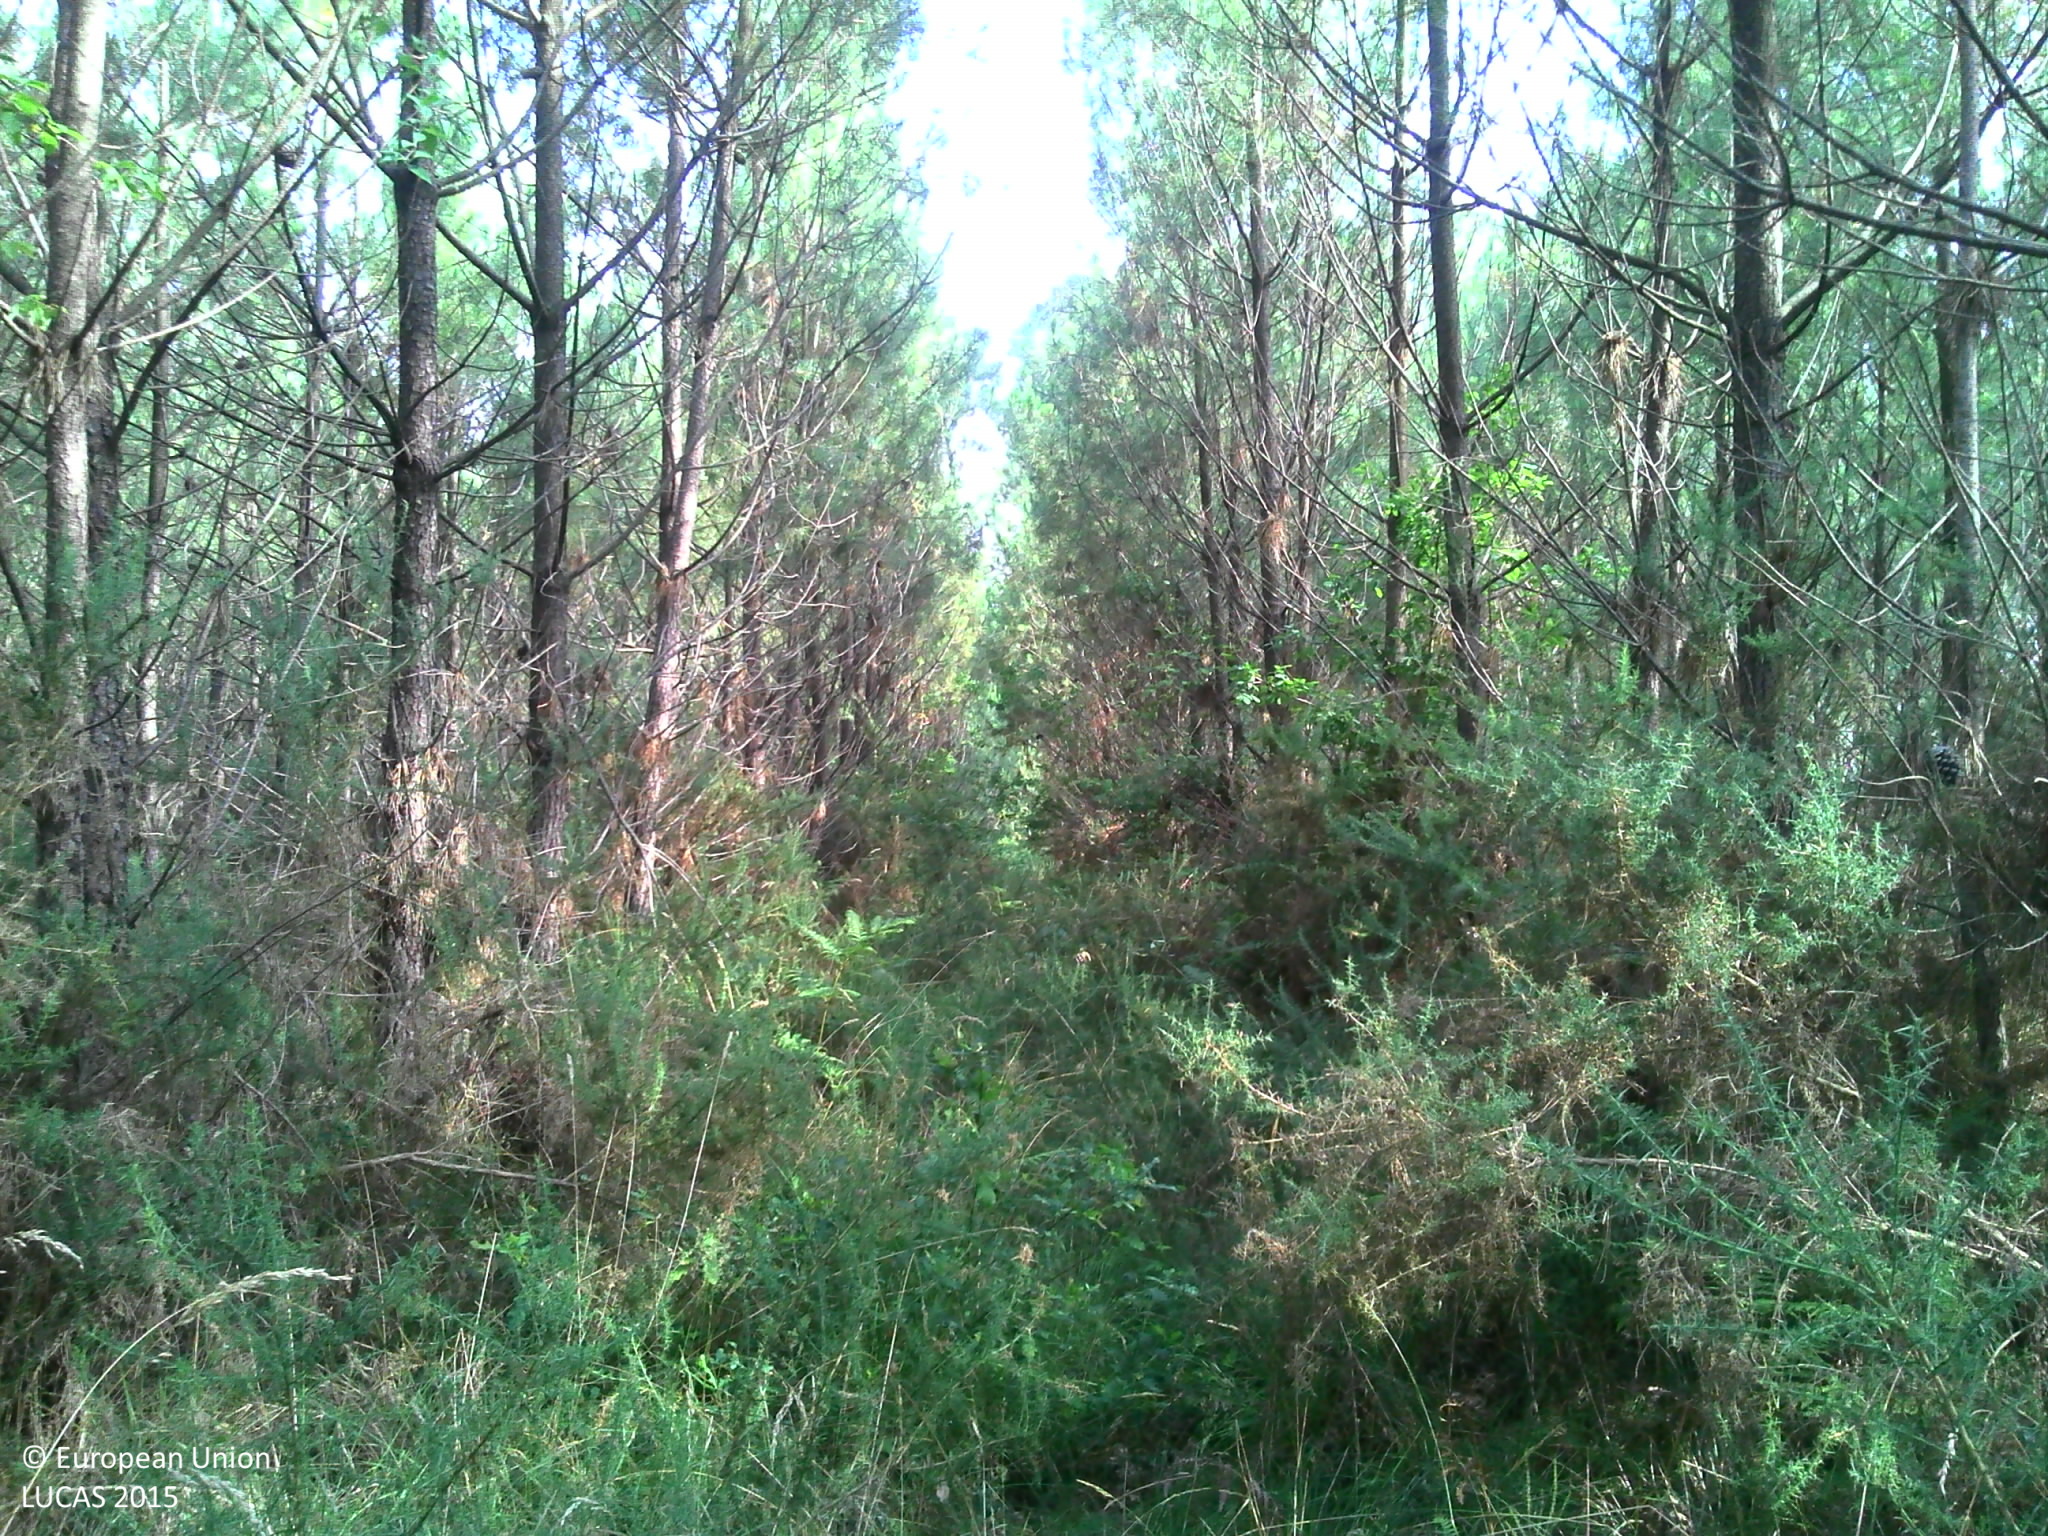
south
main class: Woodland
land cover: Pine dominated coniferous woodland
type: coniferous forest of the mediterranean region
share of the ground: > 75 %
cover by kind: coniferous forest trees 80 %, herbaceous plants 10 %, broadleaved forest trees 5 %, shrubs 5 %
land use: Forestry
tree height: > 5 m
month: July
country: FR
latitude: 43.7363
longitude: -1.2543
